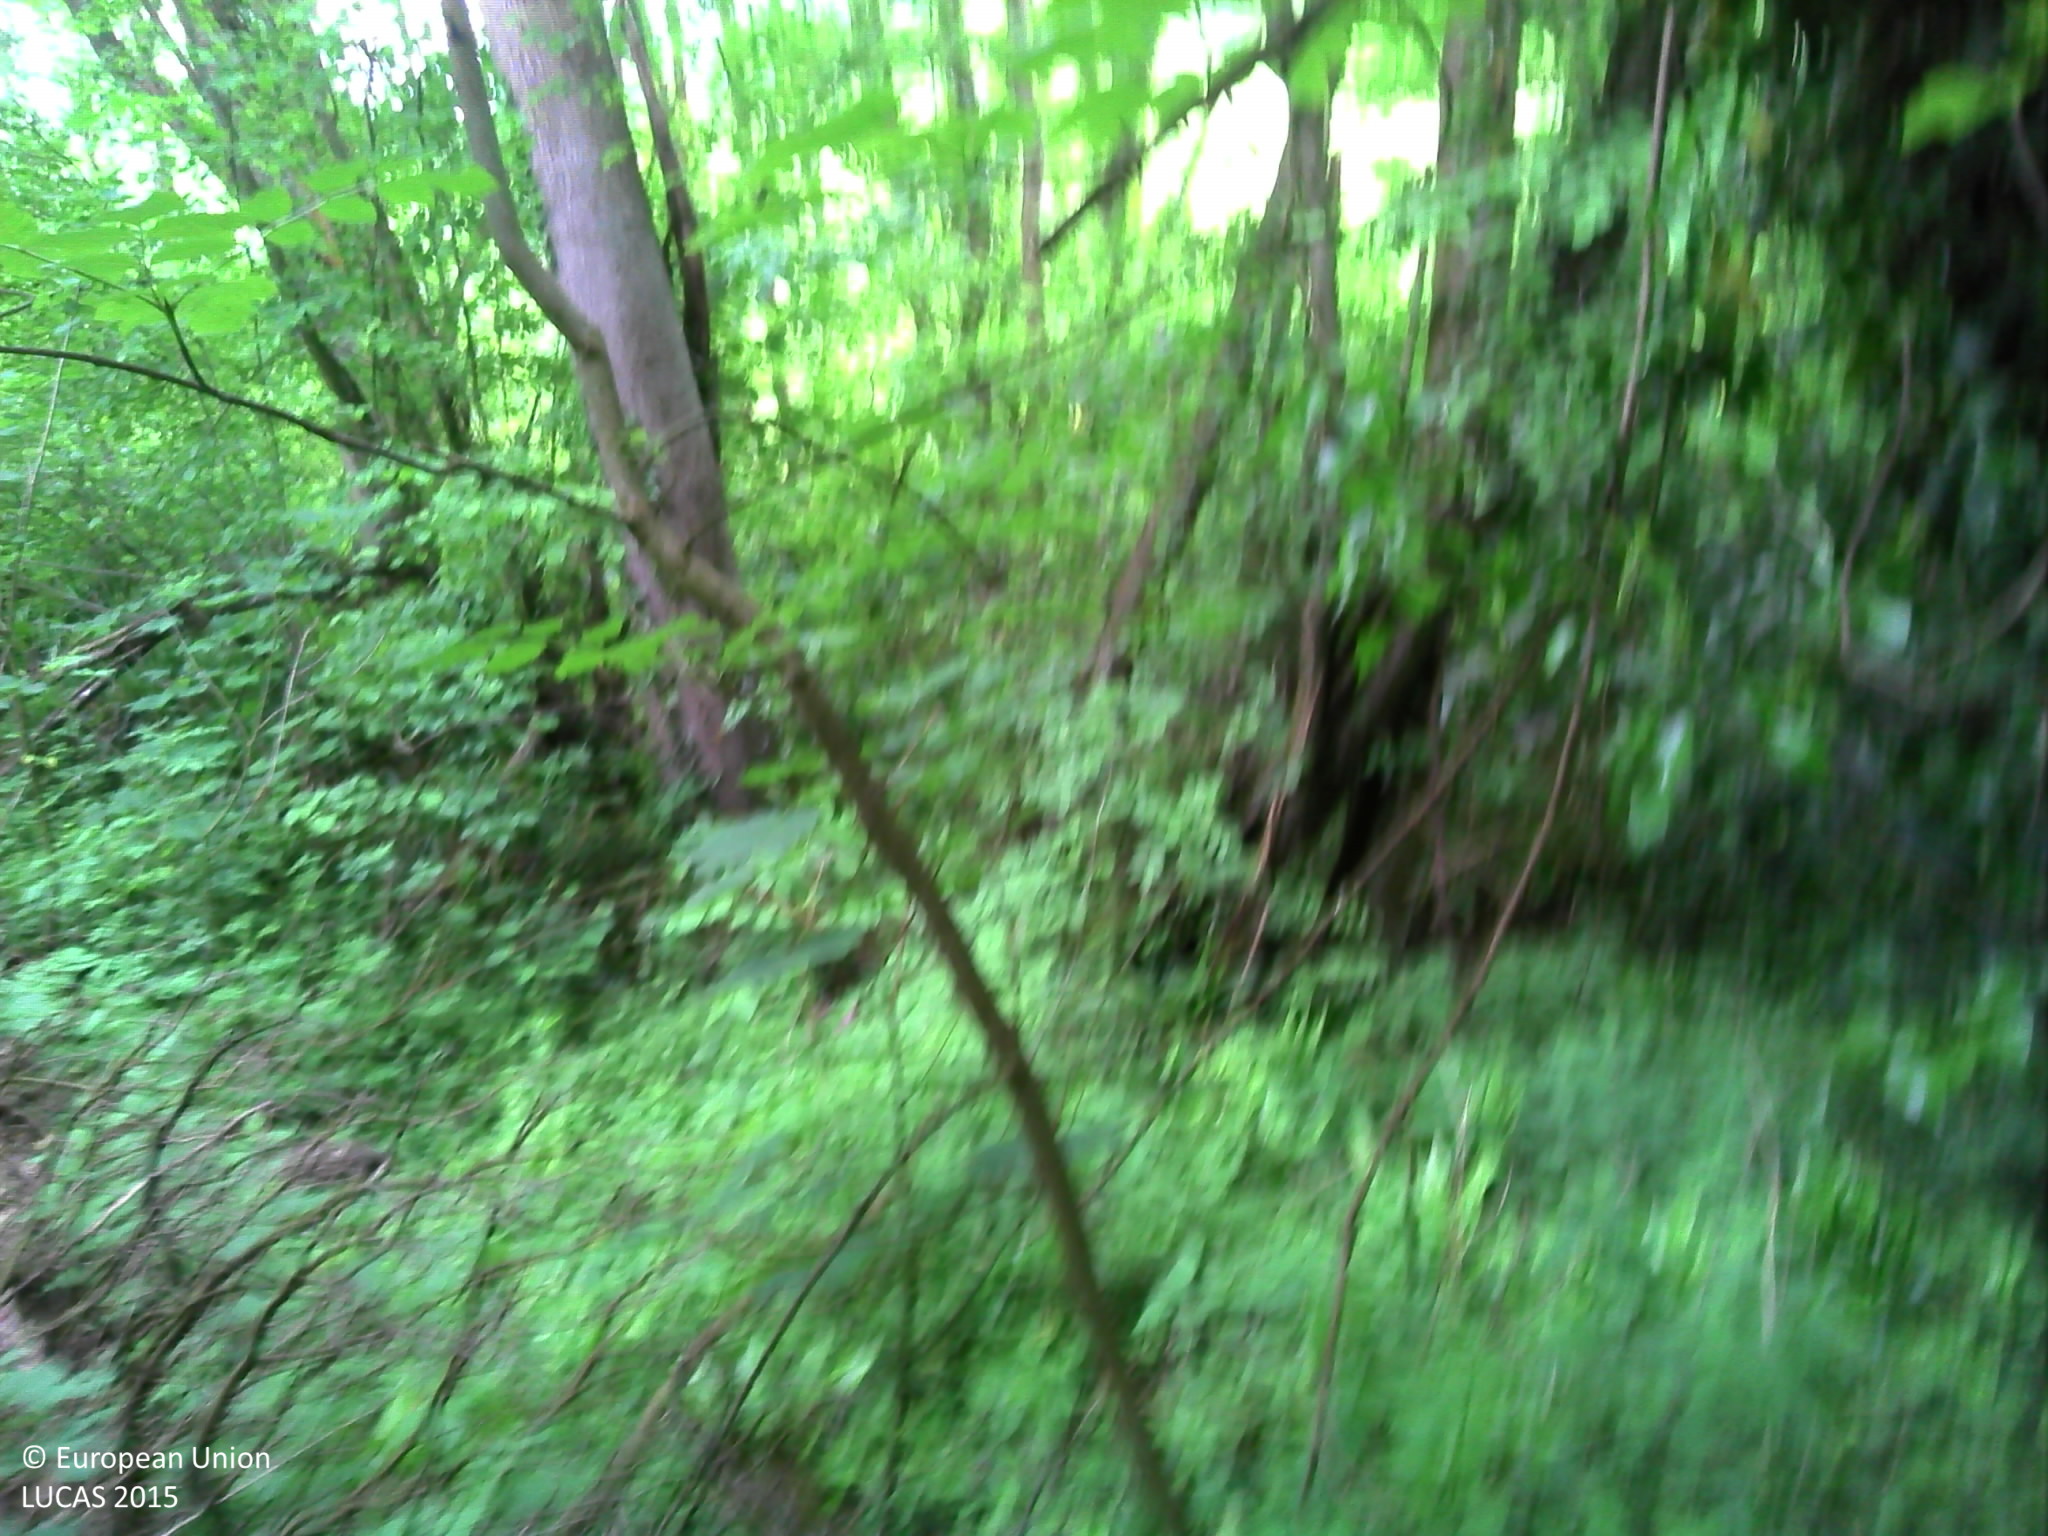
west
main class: Woodland
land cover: Broadleaved woodland
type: mesophytic deciduous forest
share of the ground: > 75 %
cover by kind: broadleaved forest trees 80 %, shrubs 15 %, herbaceous plants 5 %
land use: Semi-natural and natural areas not in use
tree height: > 5 m
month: May
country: FR
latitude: 49.2856
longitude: -0.0539
